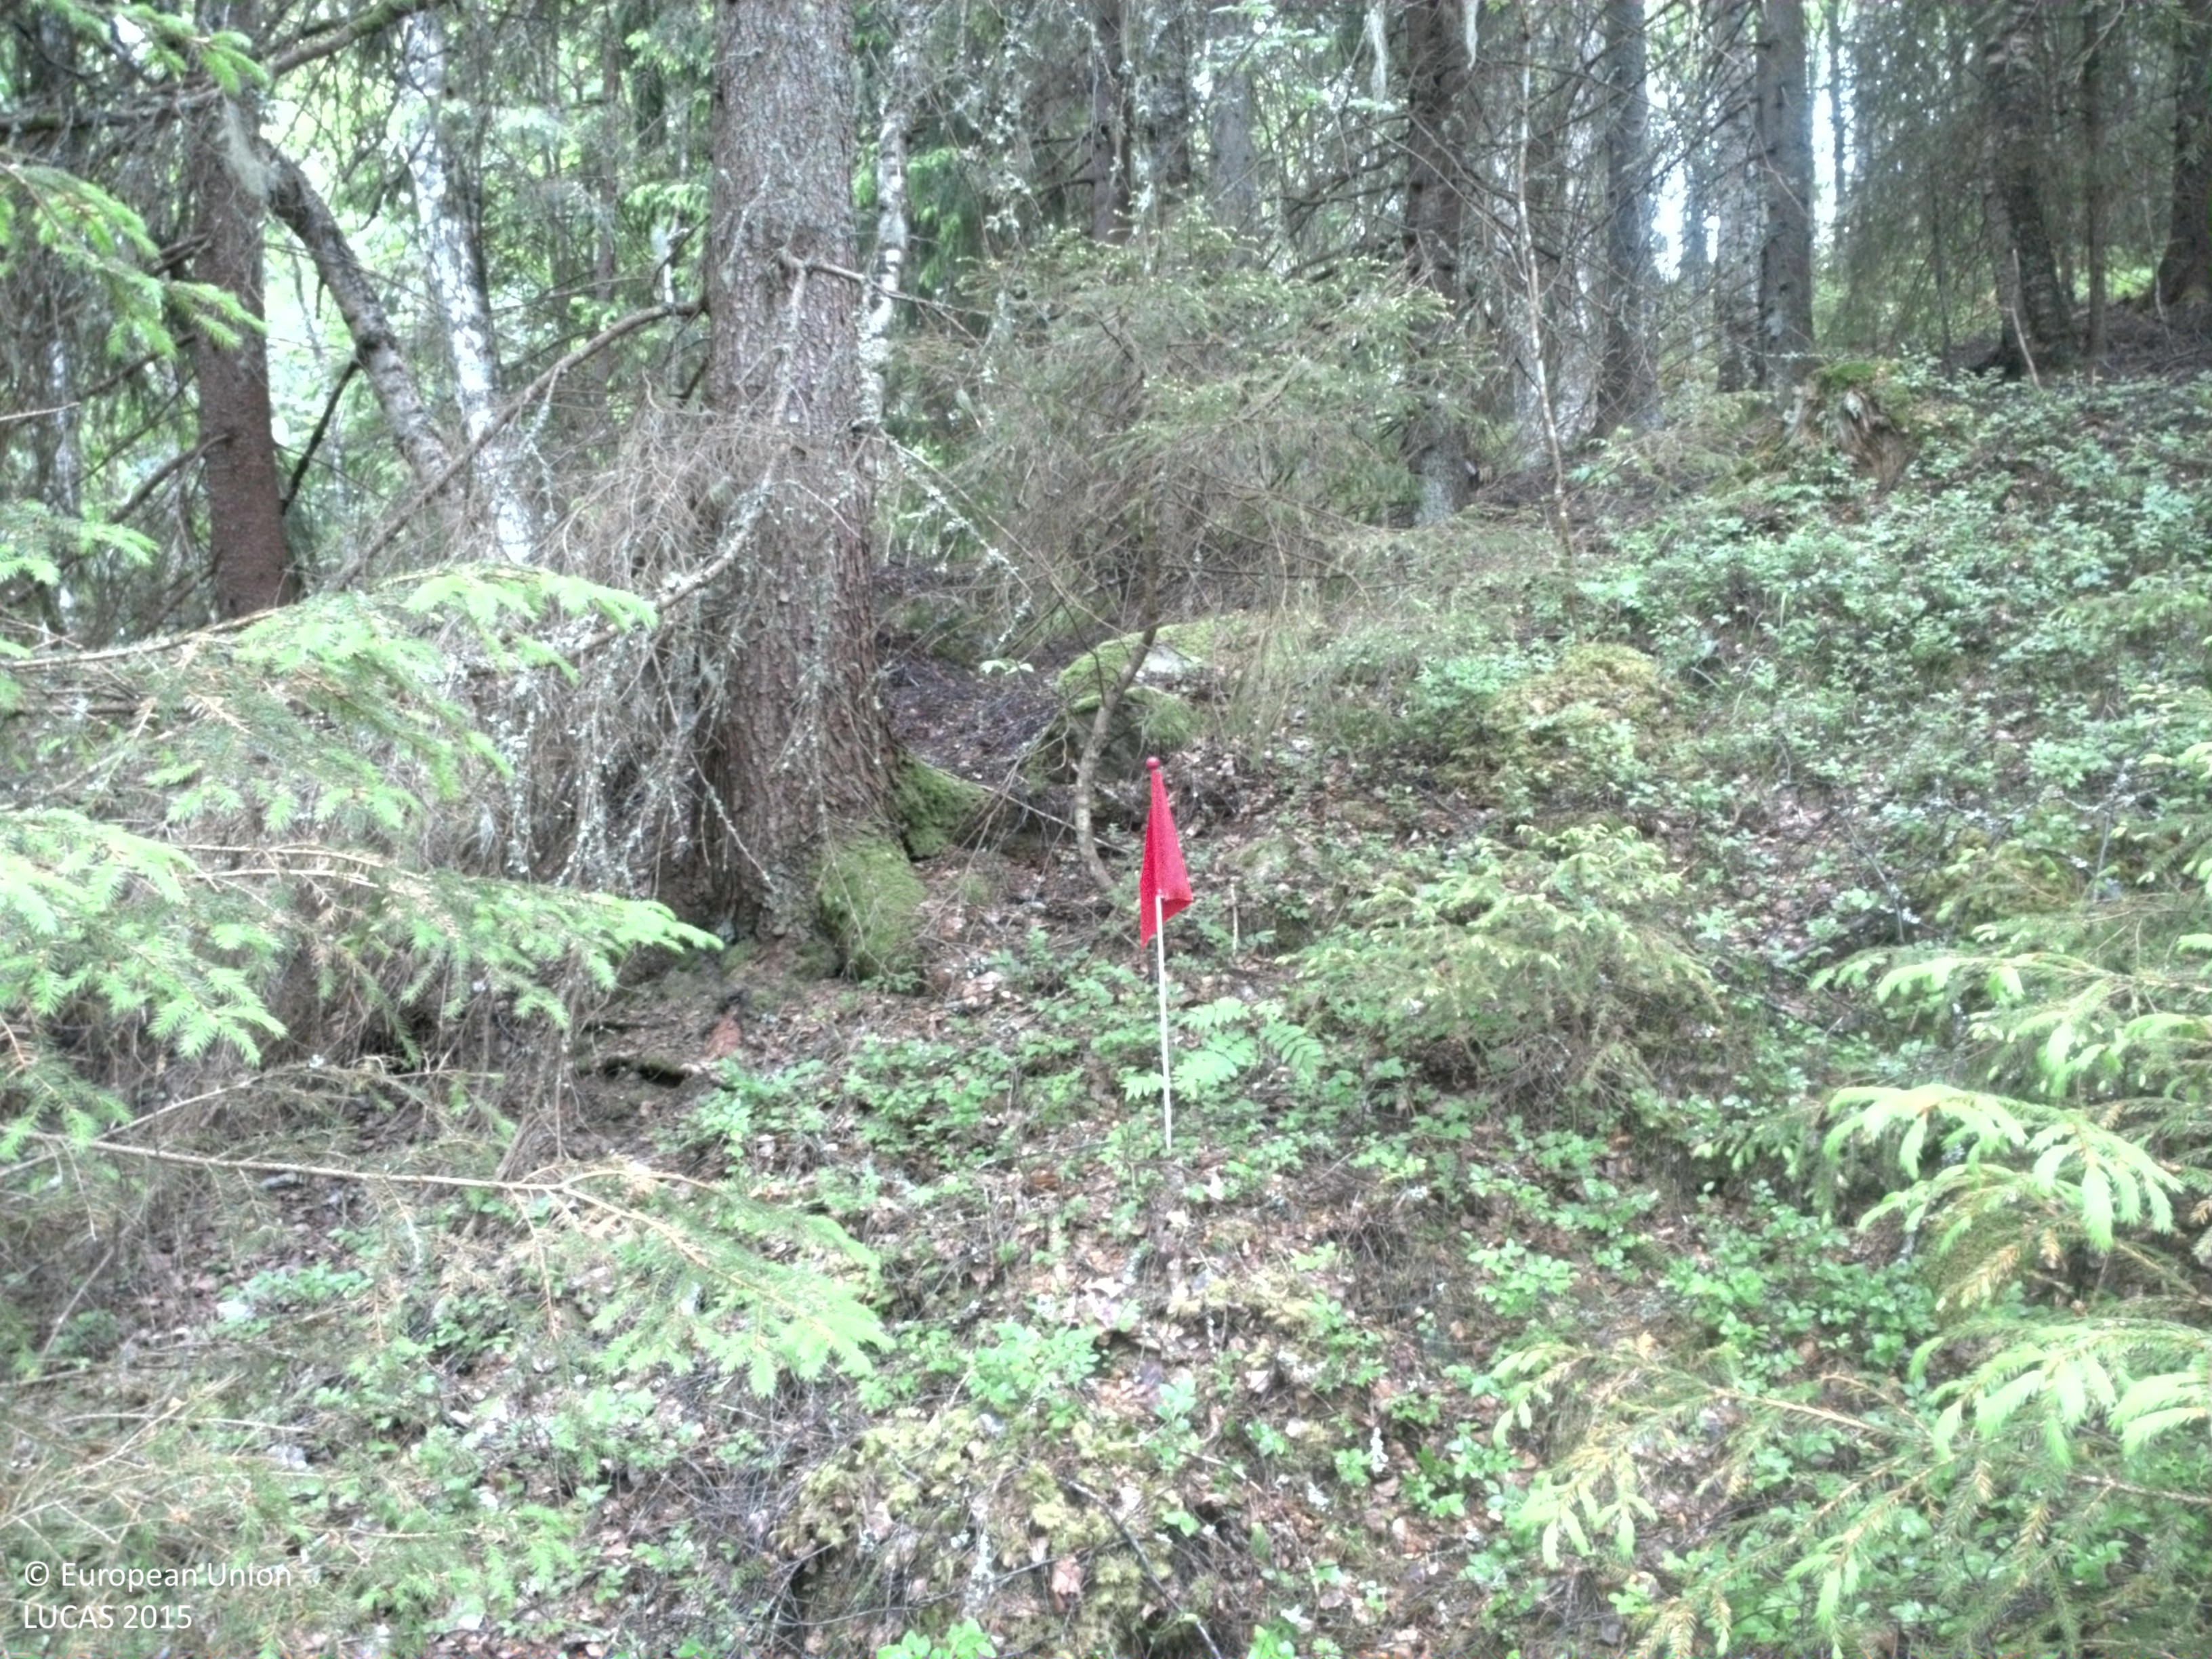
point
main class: Woodland
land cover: Spruce dominated coniferous woodland
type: boreal forest
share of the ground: > 75 %
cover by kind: coniferous forest trees 75 %, shrubs 10 %, broadleaved forest trees 5 %, herbaceous plants 5 %, lichens and mosses 5 %
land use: Forestry
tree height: > 5 m
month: June
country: SE
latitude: 59.7152
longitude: 12.0743
